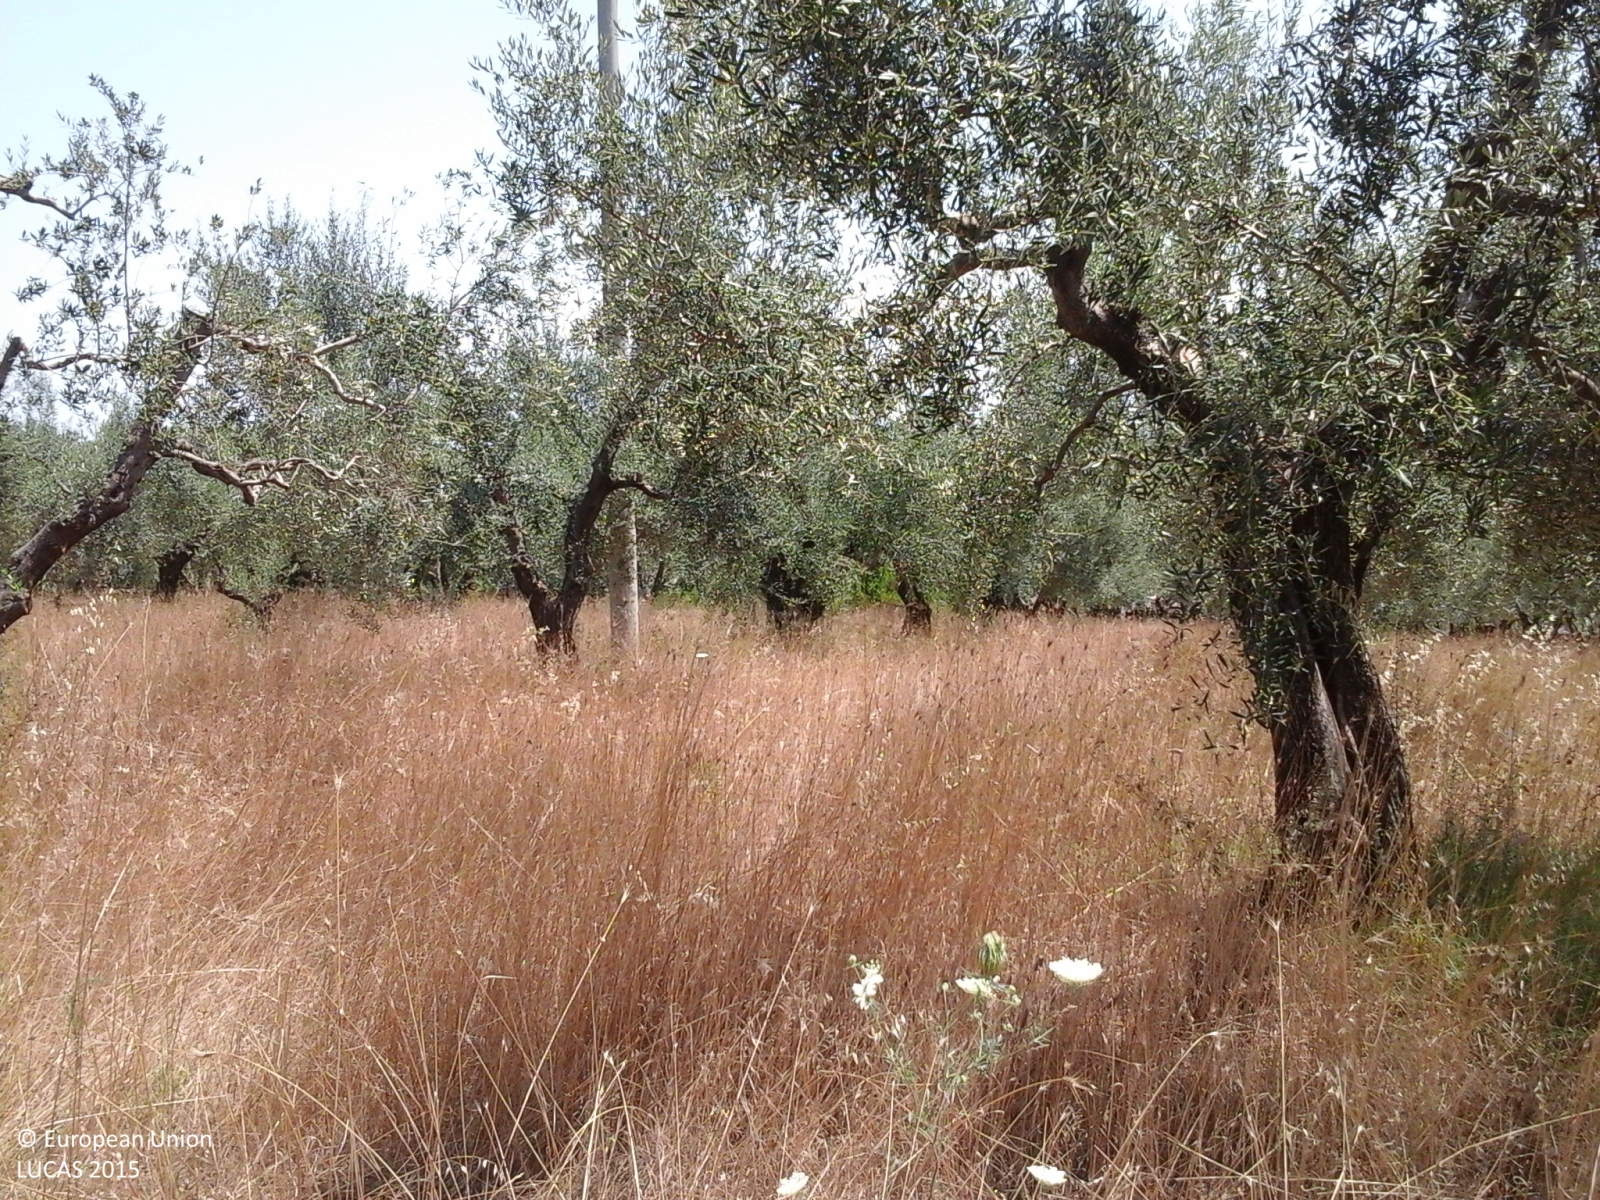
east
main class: Cropland
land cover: Olive groves
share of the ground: 50 - 75 %
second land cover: Grassland without tree/shrub cover
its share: 50 - 75 %
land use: Agriculture (excluding fallow land and kitchen gardens)
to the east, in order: Olive groves; Grassland without tree/shrub cover; Electric lines; Olive groves; Shrubland without tree cover; Olive groves; Fences; Ditches and canals; Tracks; Grass margins; Broadleaved woodland; Fences; Paved roads, cycling and walking lanes; Broadleaved woodland; Fences; Grassland without tree/shrub cover; Single bushes/trees
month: July
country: IT
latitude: 42.4266
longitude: 11.4656
